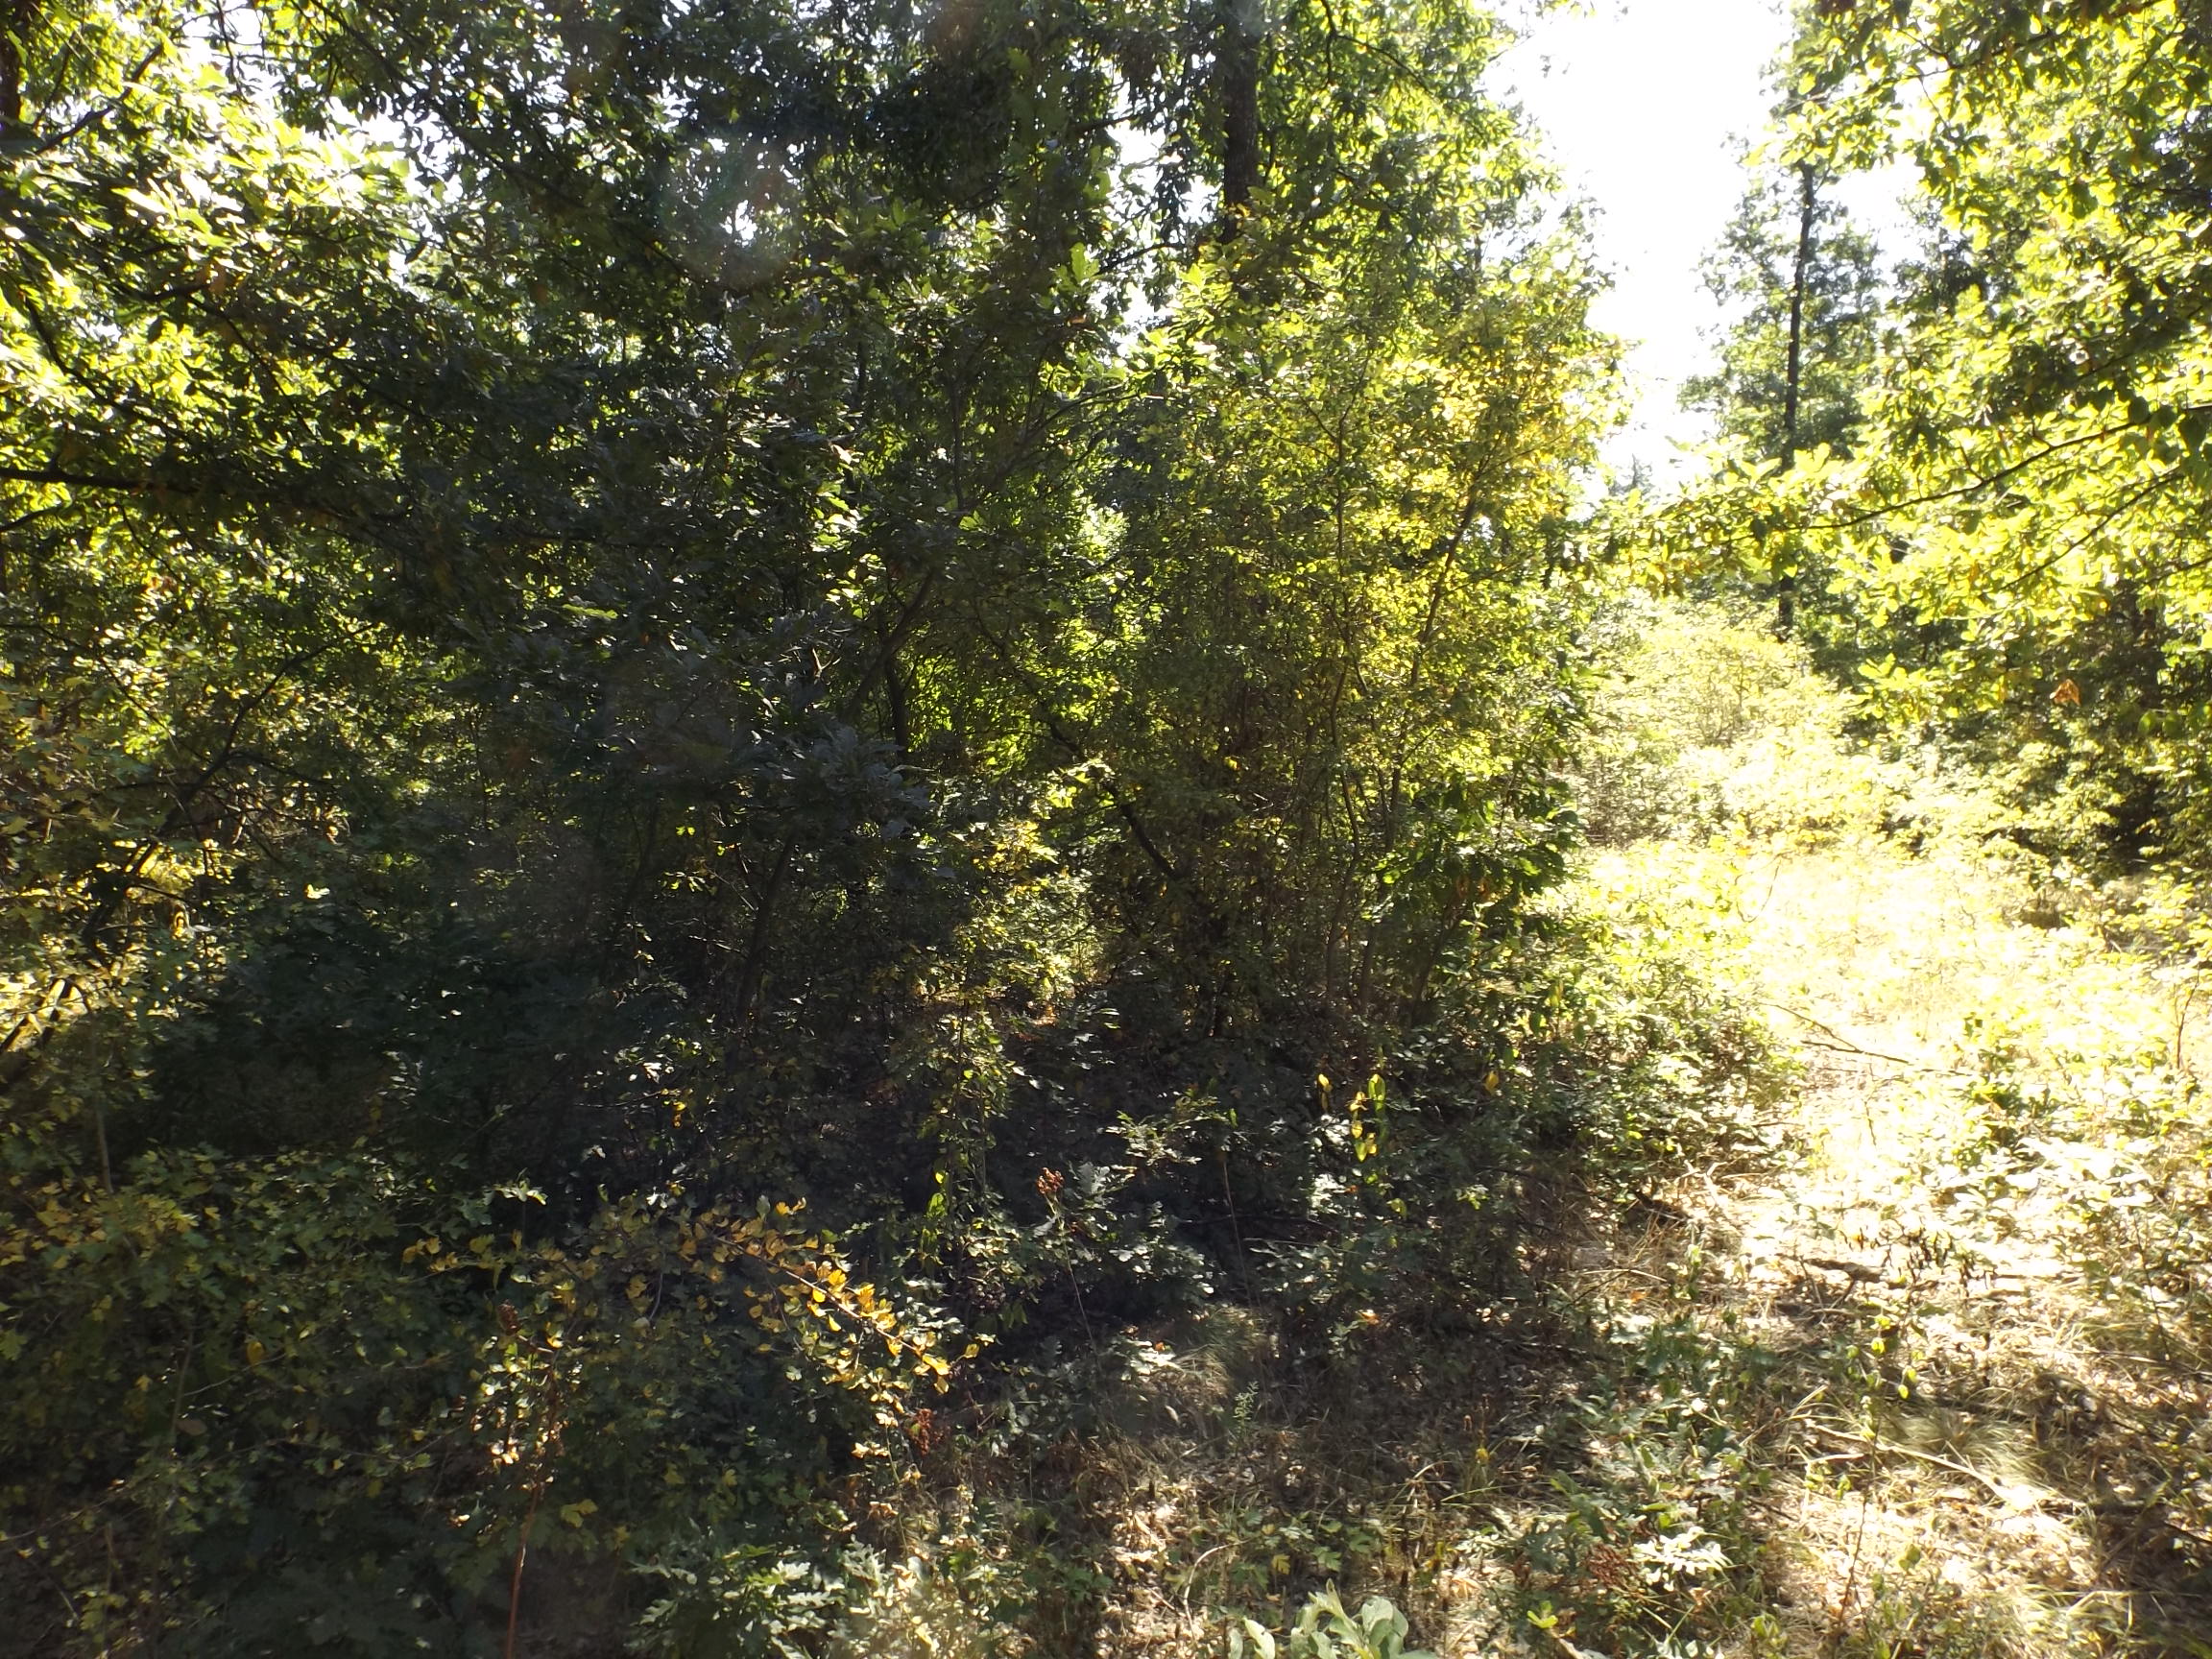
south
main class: Woodland
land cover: Broadleaved woodland
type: mesophytic deciduous forest
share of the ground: > 75 %
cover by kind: broadleaved forest trees 85 %, herbaceous plants 10 %, shrubs 5 %
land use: Forestry
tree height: > 5 m
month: September
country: BG
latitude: 43.4112
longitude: 27.6582
